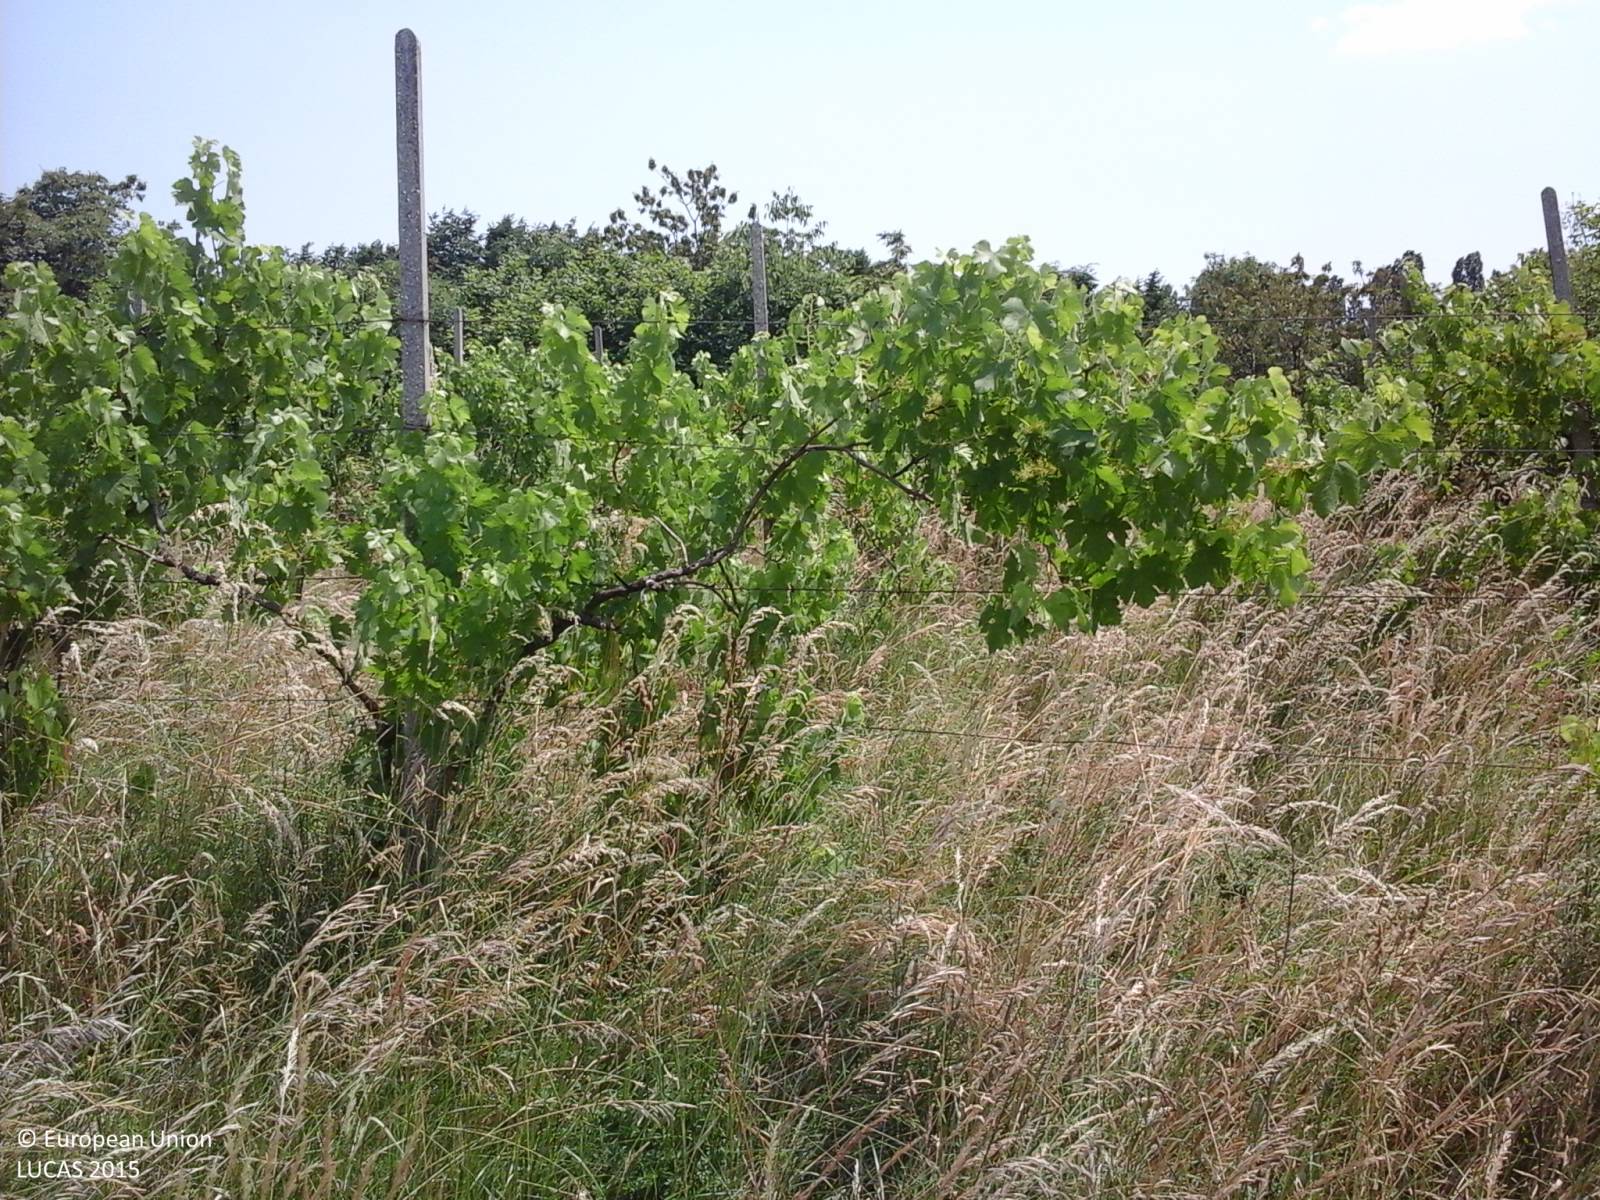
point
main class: Cropland
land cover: Vineyards
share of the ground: > 75 %
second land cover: Grassland without tree/shrub cover
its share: > 75 %
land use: Agriculture (excluding fallow land and kitchen gardens)
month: June
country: IT
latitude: 46.0507
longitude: 12.5429
